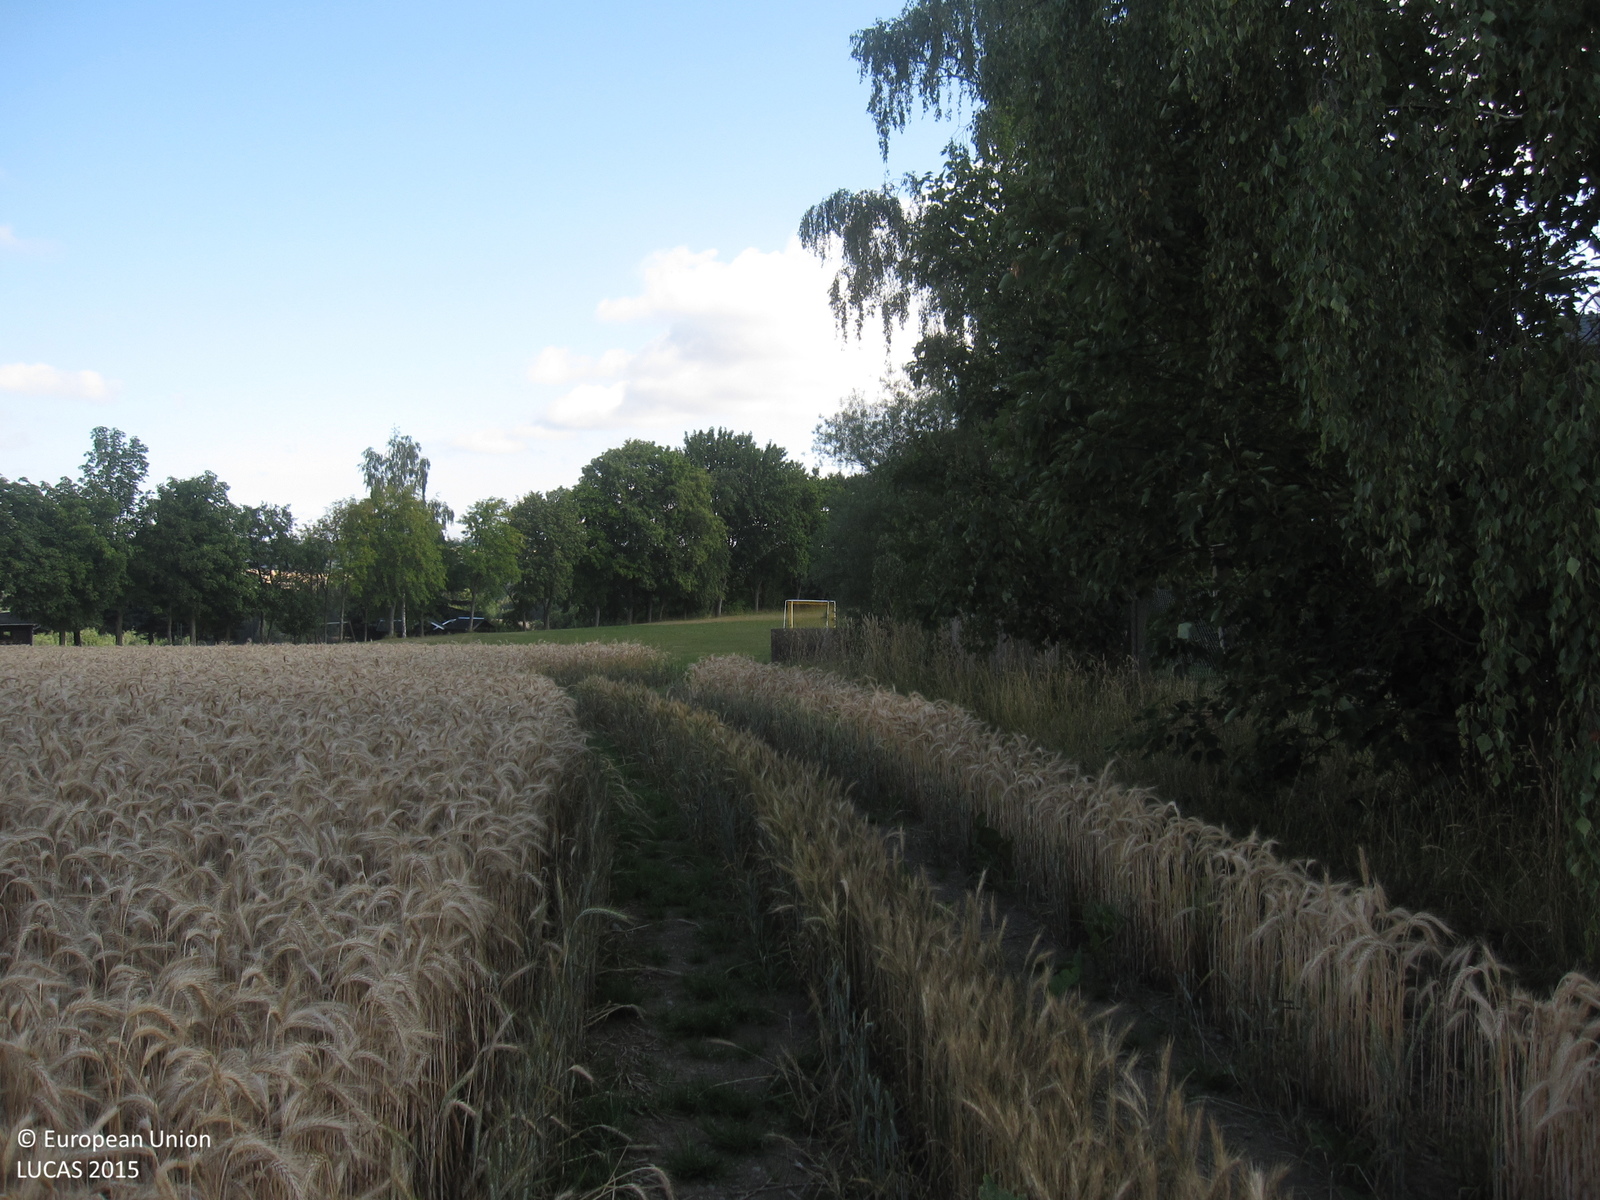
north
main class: Cropland
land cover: Durum wheat
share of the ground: > 75 %
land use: Agriculture (excluding fallow land and kitchen gardens)
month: July
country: DE
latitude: 50.4188
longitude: 11.9841
